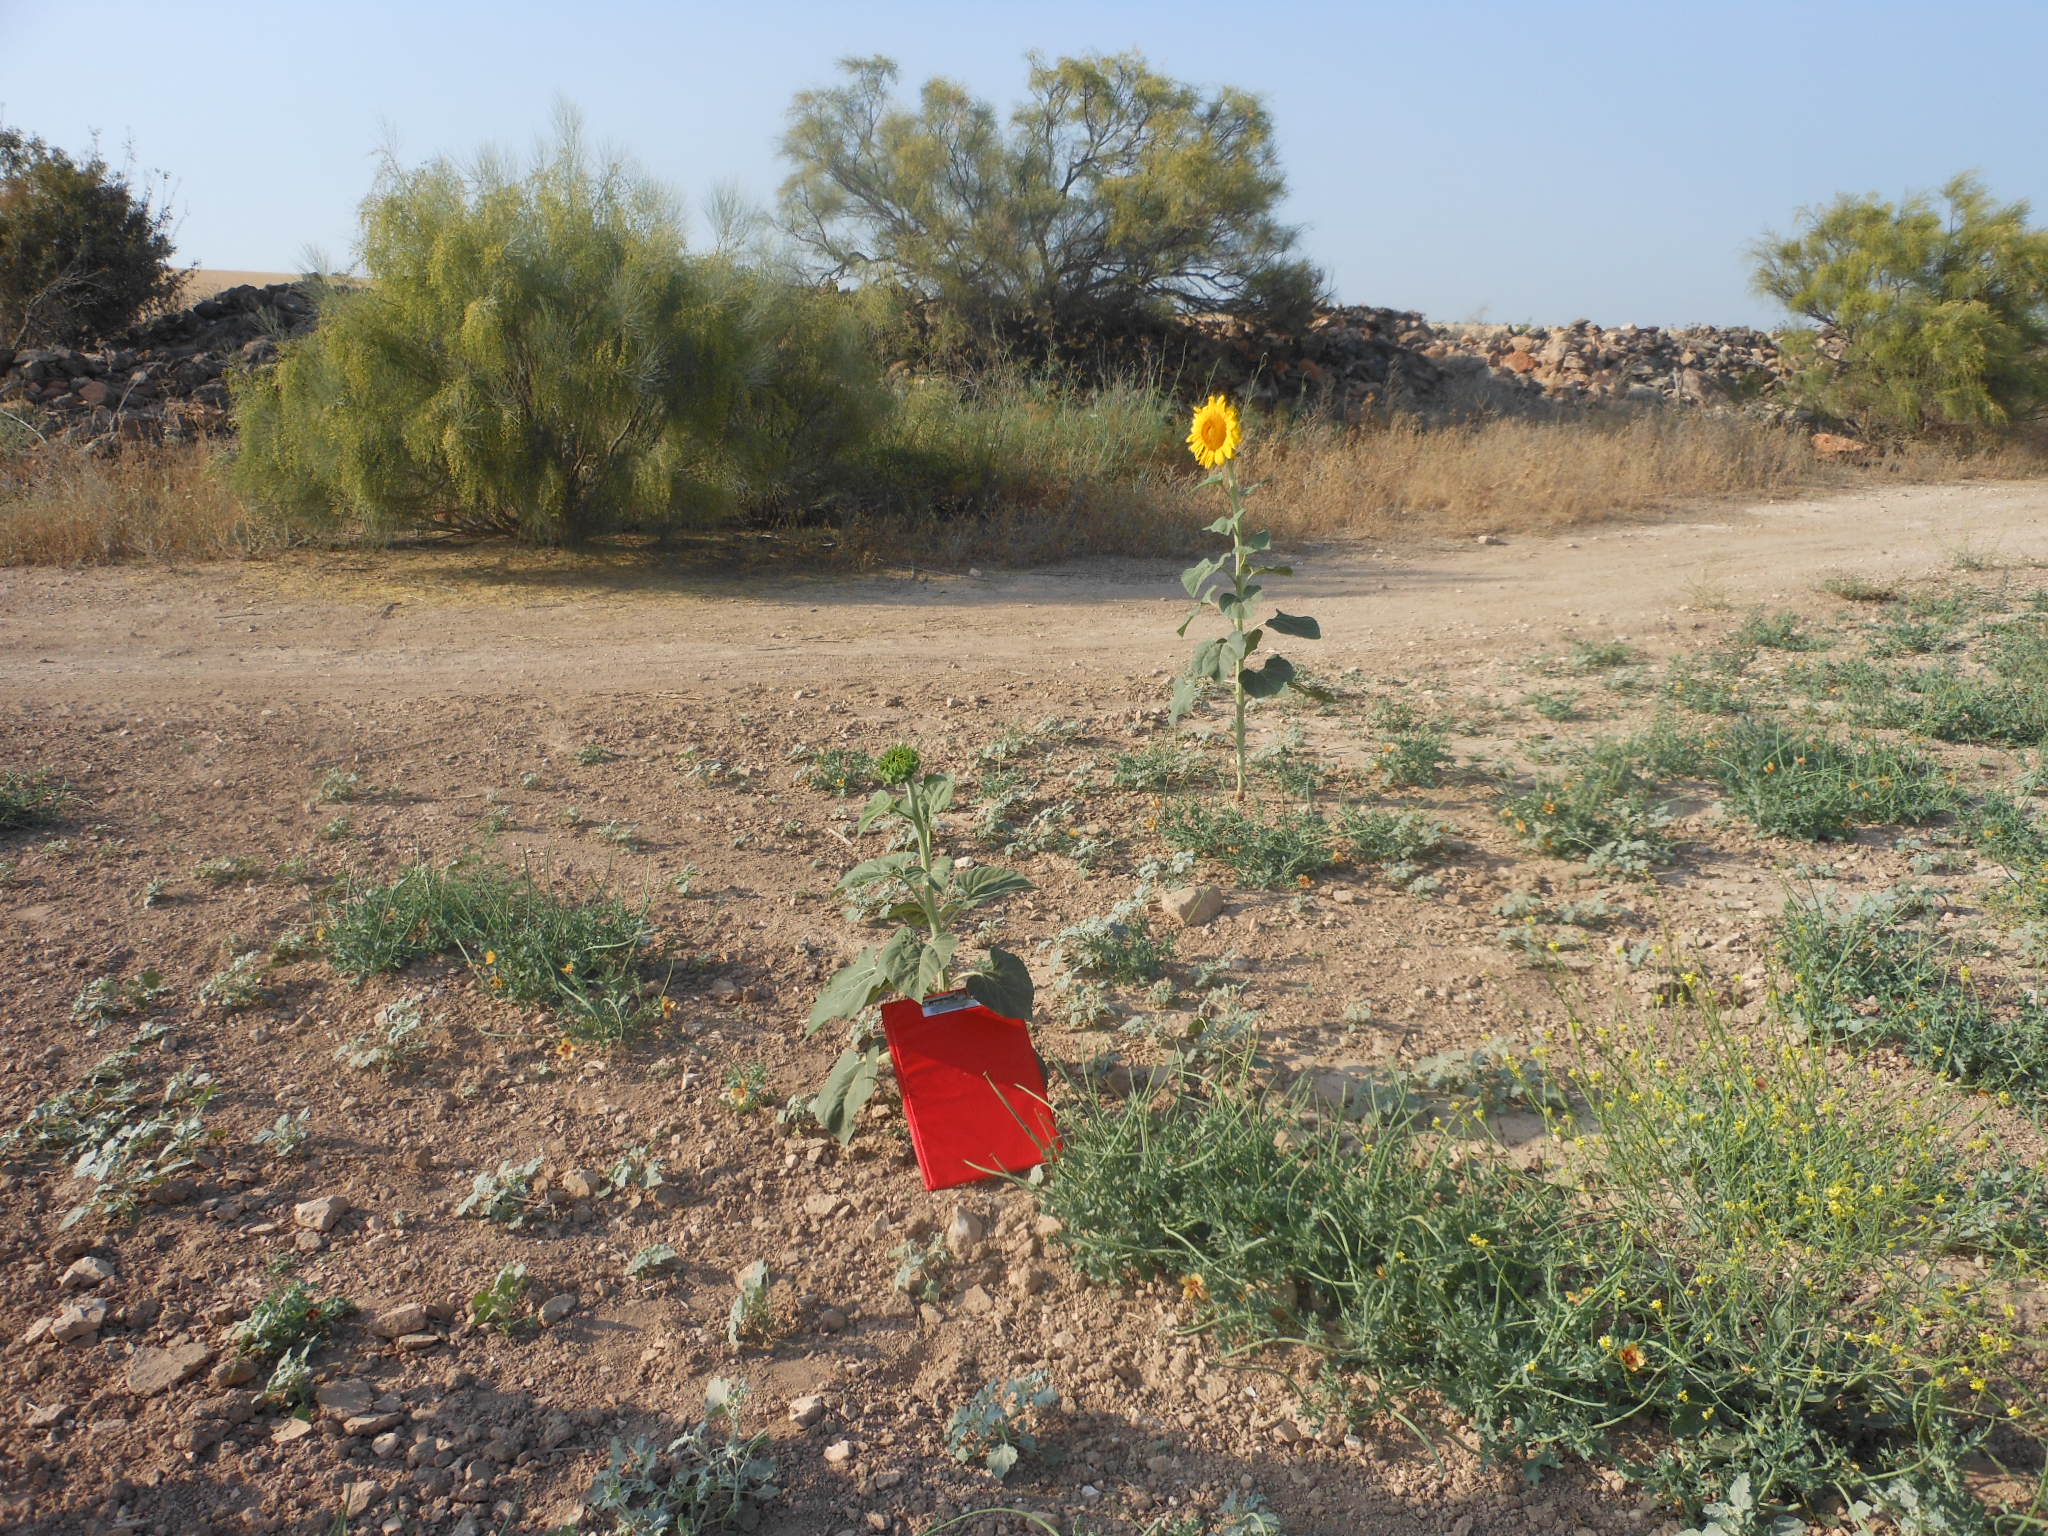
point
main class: Cropland
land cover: Sunflower
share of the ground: 25 - 50 %
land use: Agriculture (excluding fallow land and kitchen gardens)
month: June
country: ES
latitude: 37.2942
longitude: -5.0677
